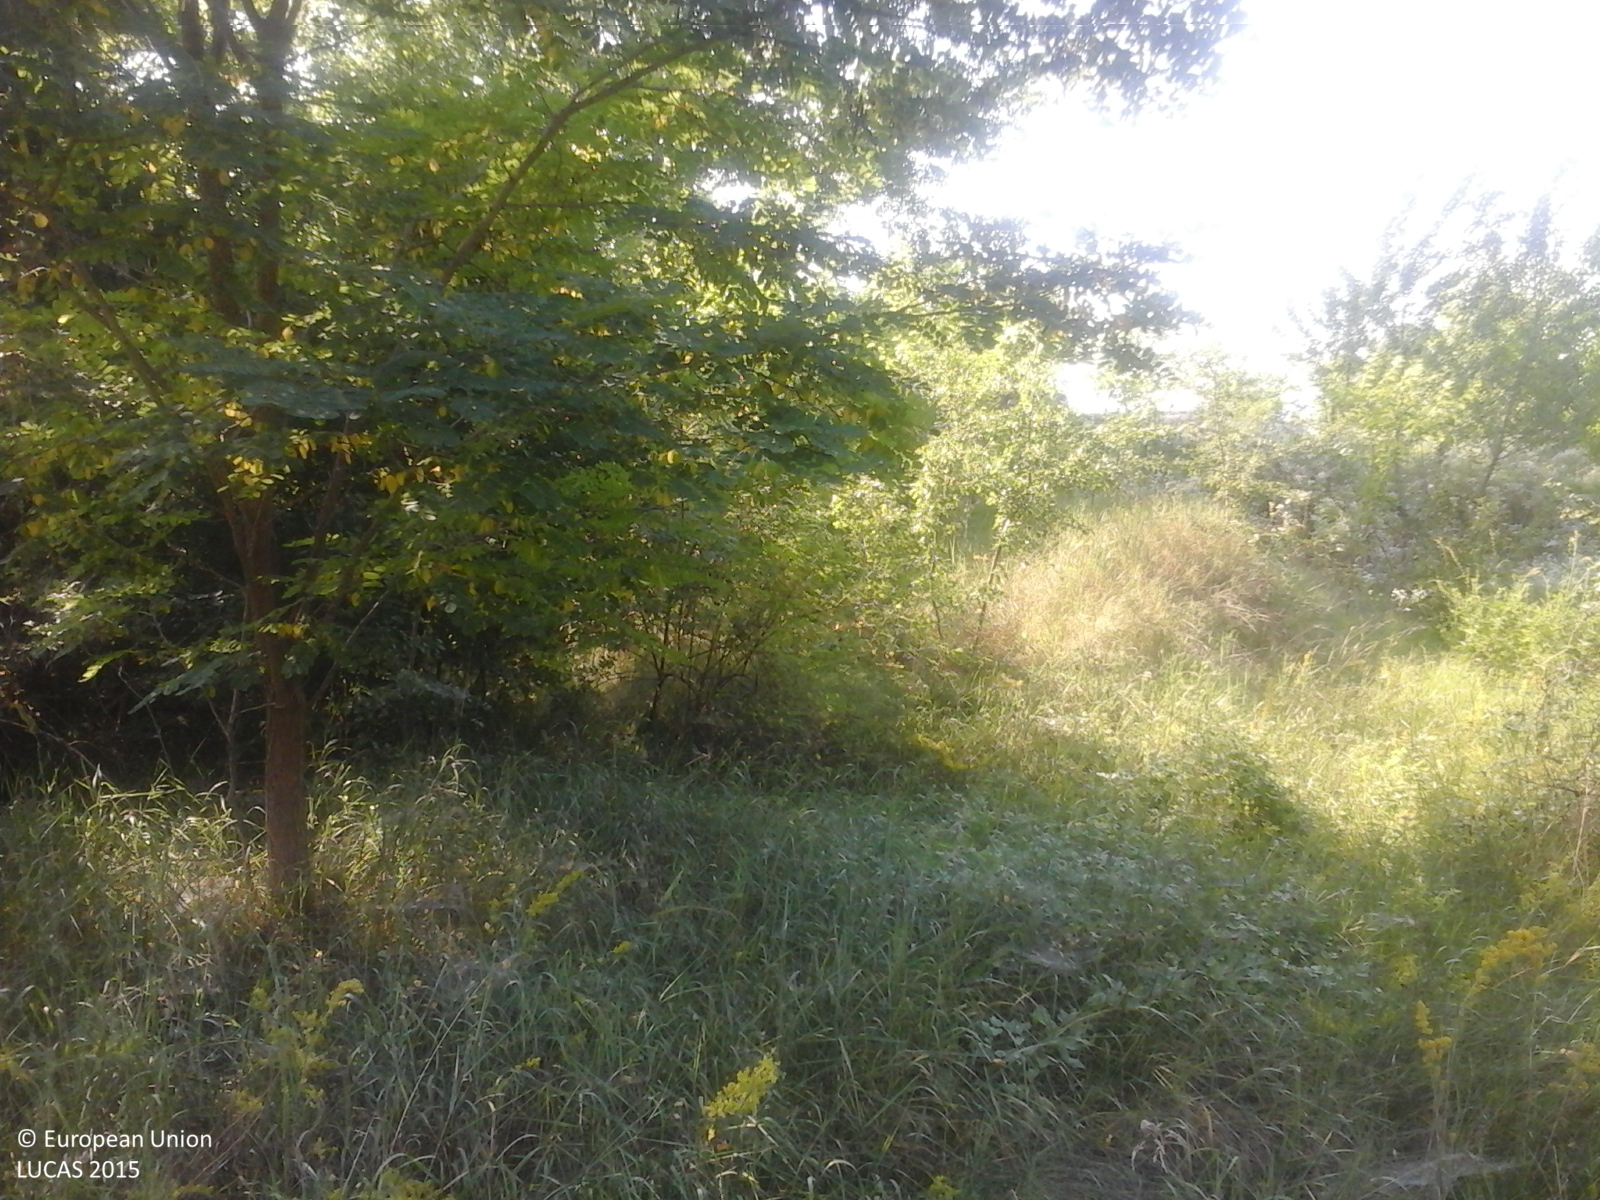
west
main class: Grassland
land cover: Grassland with sparse tree/shrub cover
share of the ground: > 75 %
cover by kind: herbaceous plants 85 %, shrubs 10 %, broadleaved forest trees 5 %
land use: Agriculture (excluding fallow land and kitchen gardens)
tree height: < 5 m
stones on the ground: < 10 %
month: July
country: RO
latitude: 44.6611
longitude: 25.3889
